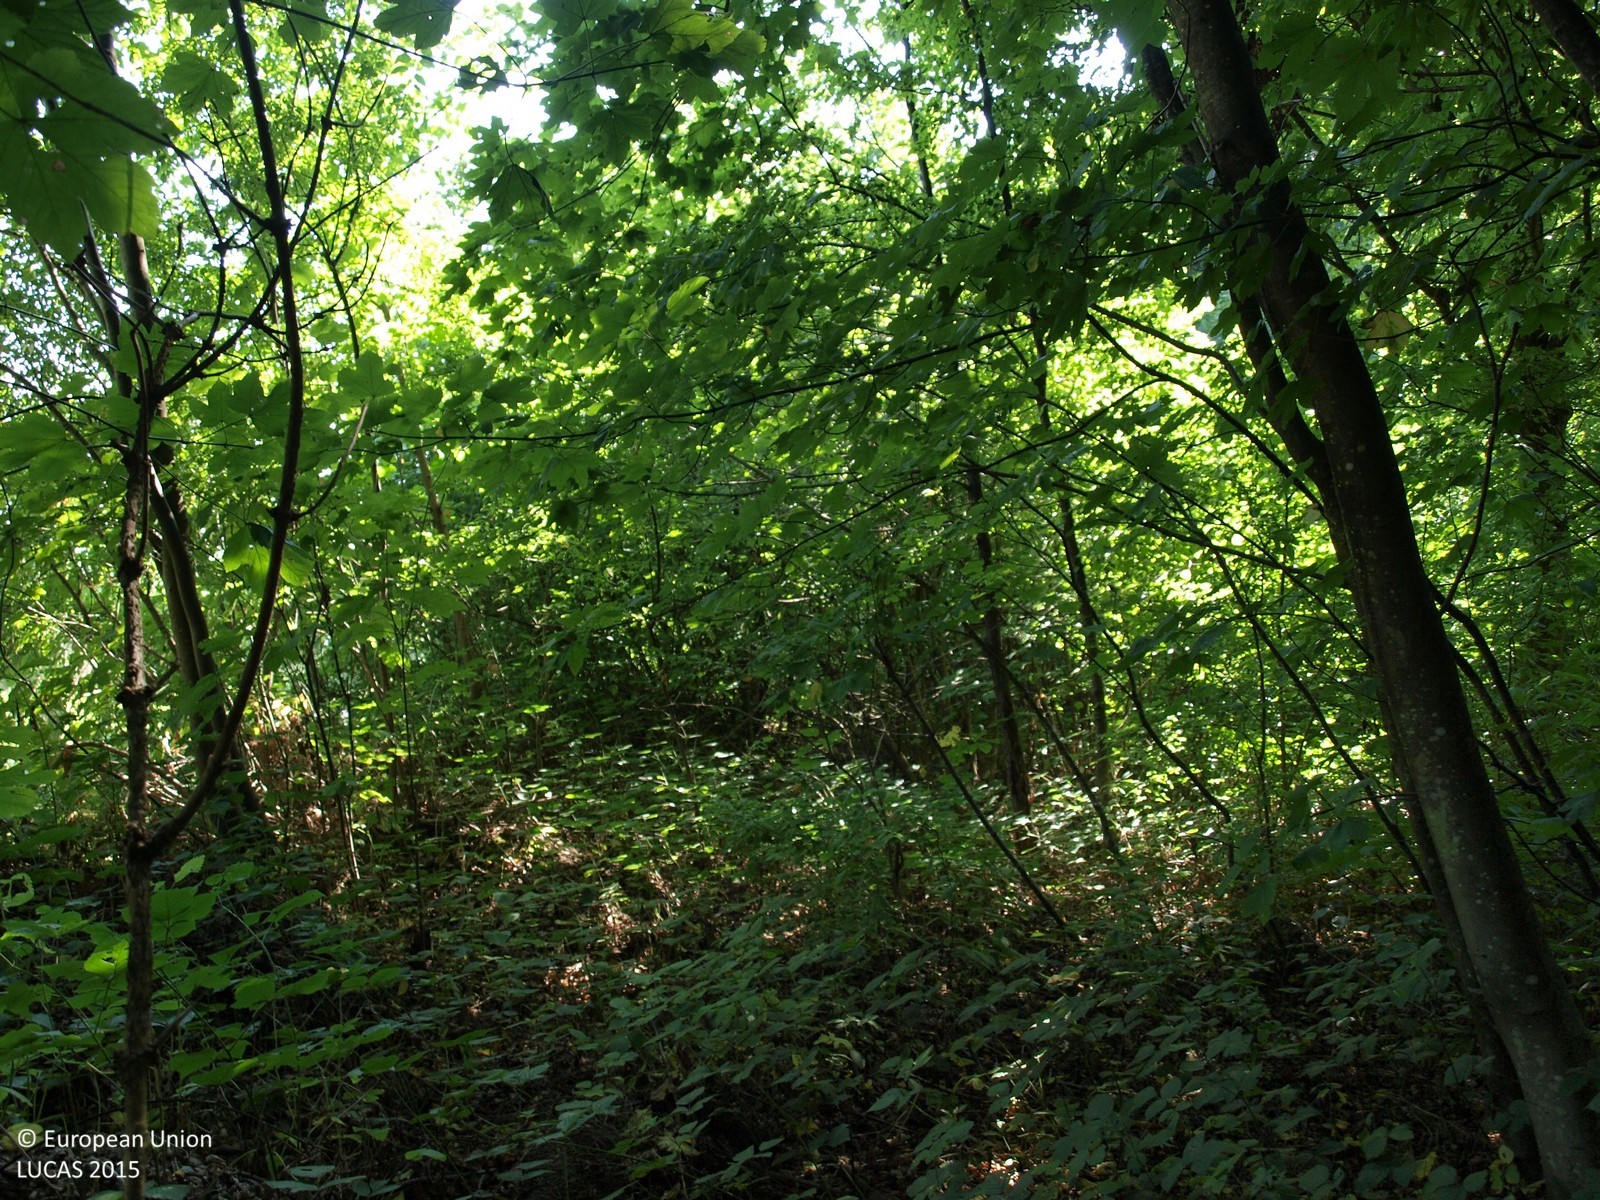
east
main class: Woodland
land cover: Broadleaved woodland
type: mesophytic deciduous forest
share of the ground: > 75 %
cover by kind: broadleaved forest trees 100 %
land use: Forestry
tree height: > 5 m
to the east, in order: Broadleaved woodland; Tracks; Broadleaved woodland; Grassland without tree/shrub cover; Shrubland with sparse tree cover
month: August
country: HR
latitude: 45.8780
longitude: 16.2733
